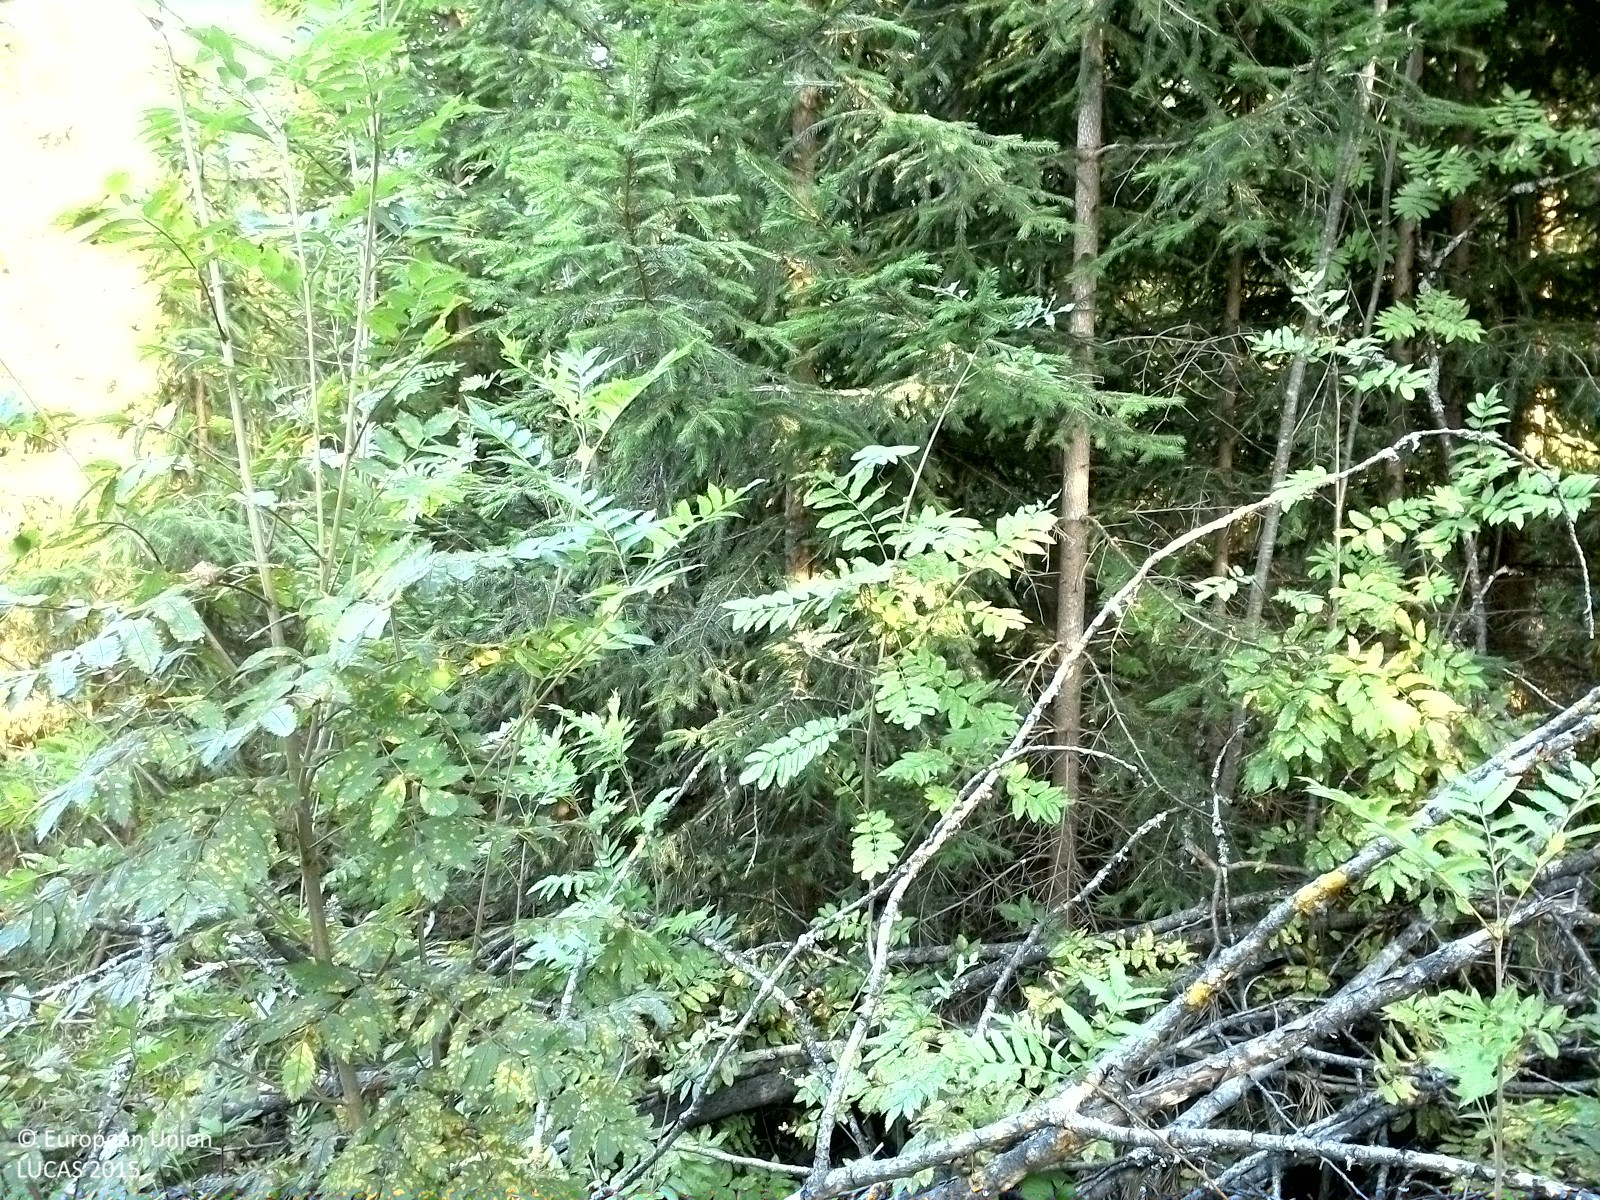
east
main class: Woodland
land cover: Other mixed woodland
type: boreal forest
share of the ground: 50 - 75 %
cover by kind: coniferous forest trees 40 %, broadleaved forest trees 20 %, herbaceous plants 20 %
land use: Forestry
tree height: > 5 m
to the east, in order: Other mixed woodland; Grassland with sparse tree/shrub cover; Other mixed woodland; Other leguminous and mixtures for fodder; Other mixed woodland; Ditches and canals; Other mixed woodland; Spruce dominated coniferous woodland; Spruce dominated mixed woodland
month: August
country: SE
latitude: 62.3414
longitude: 16.9899
